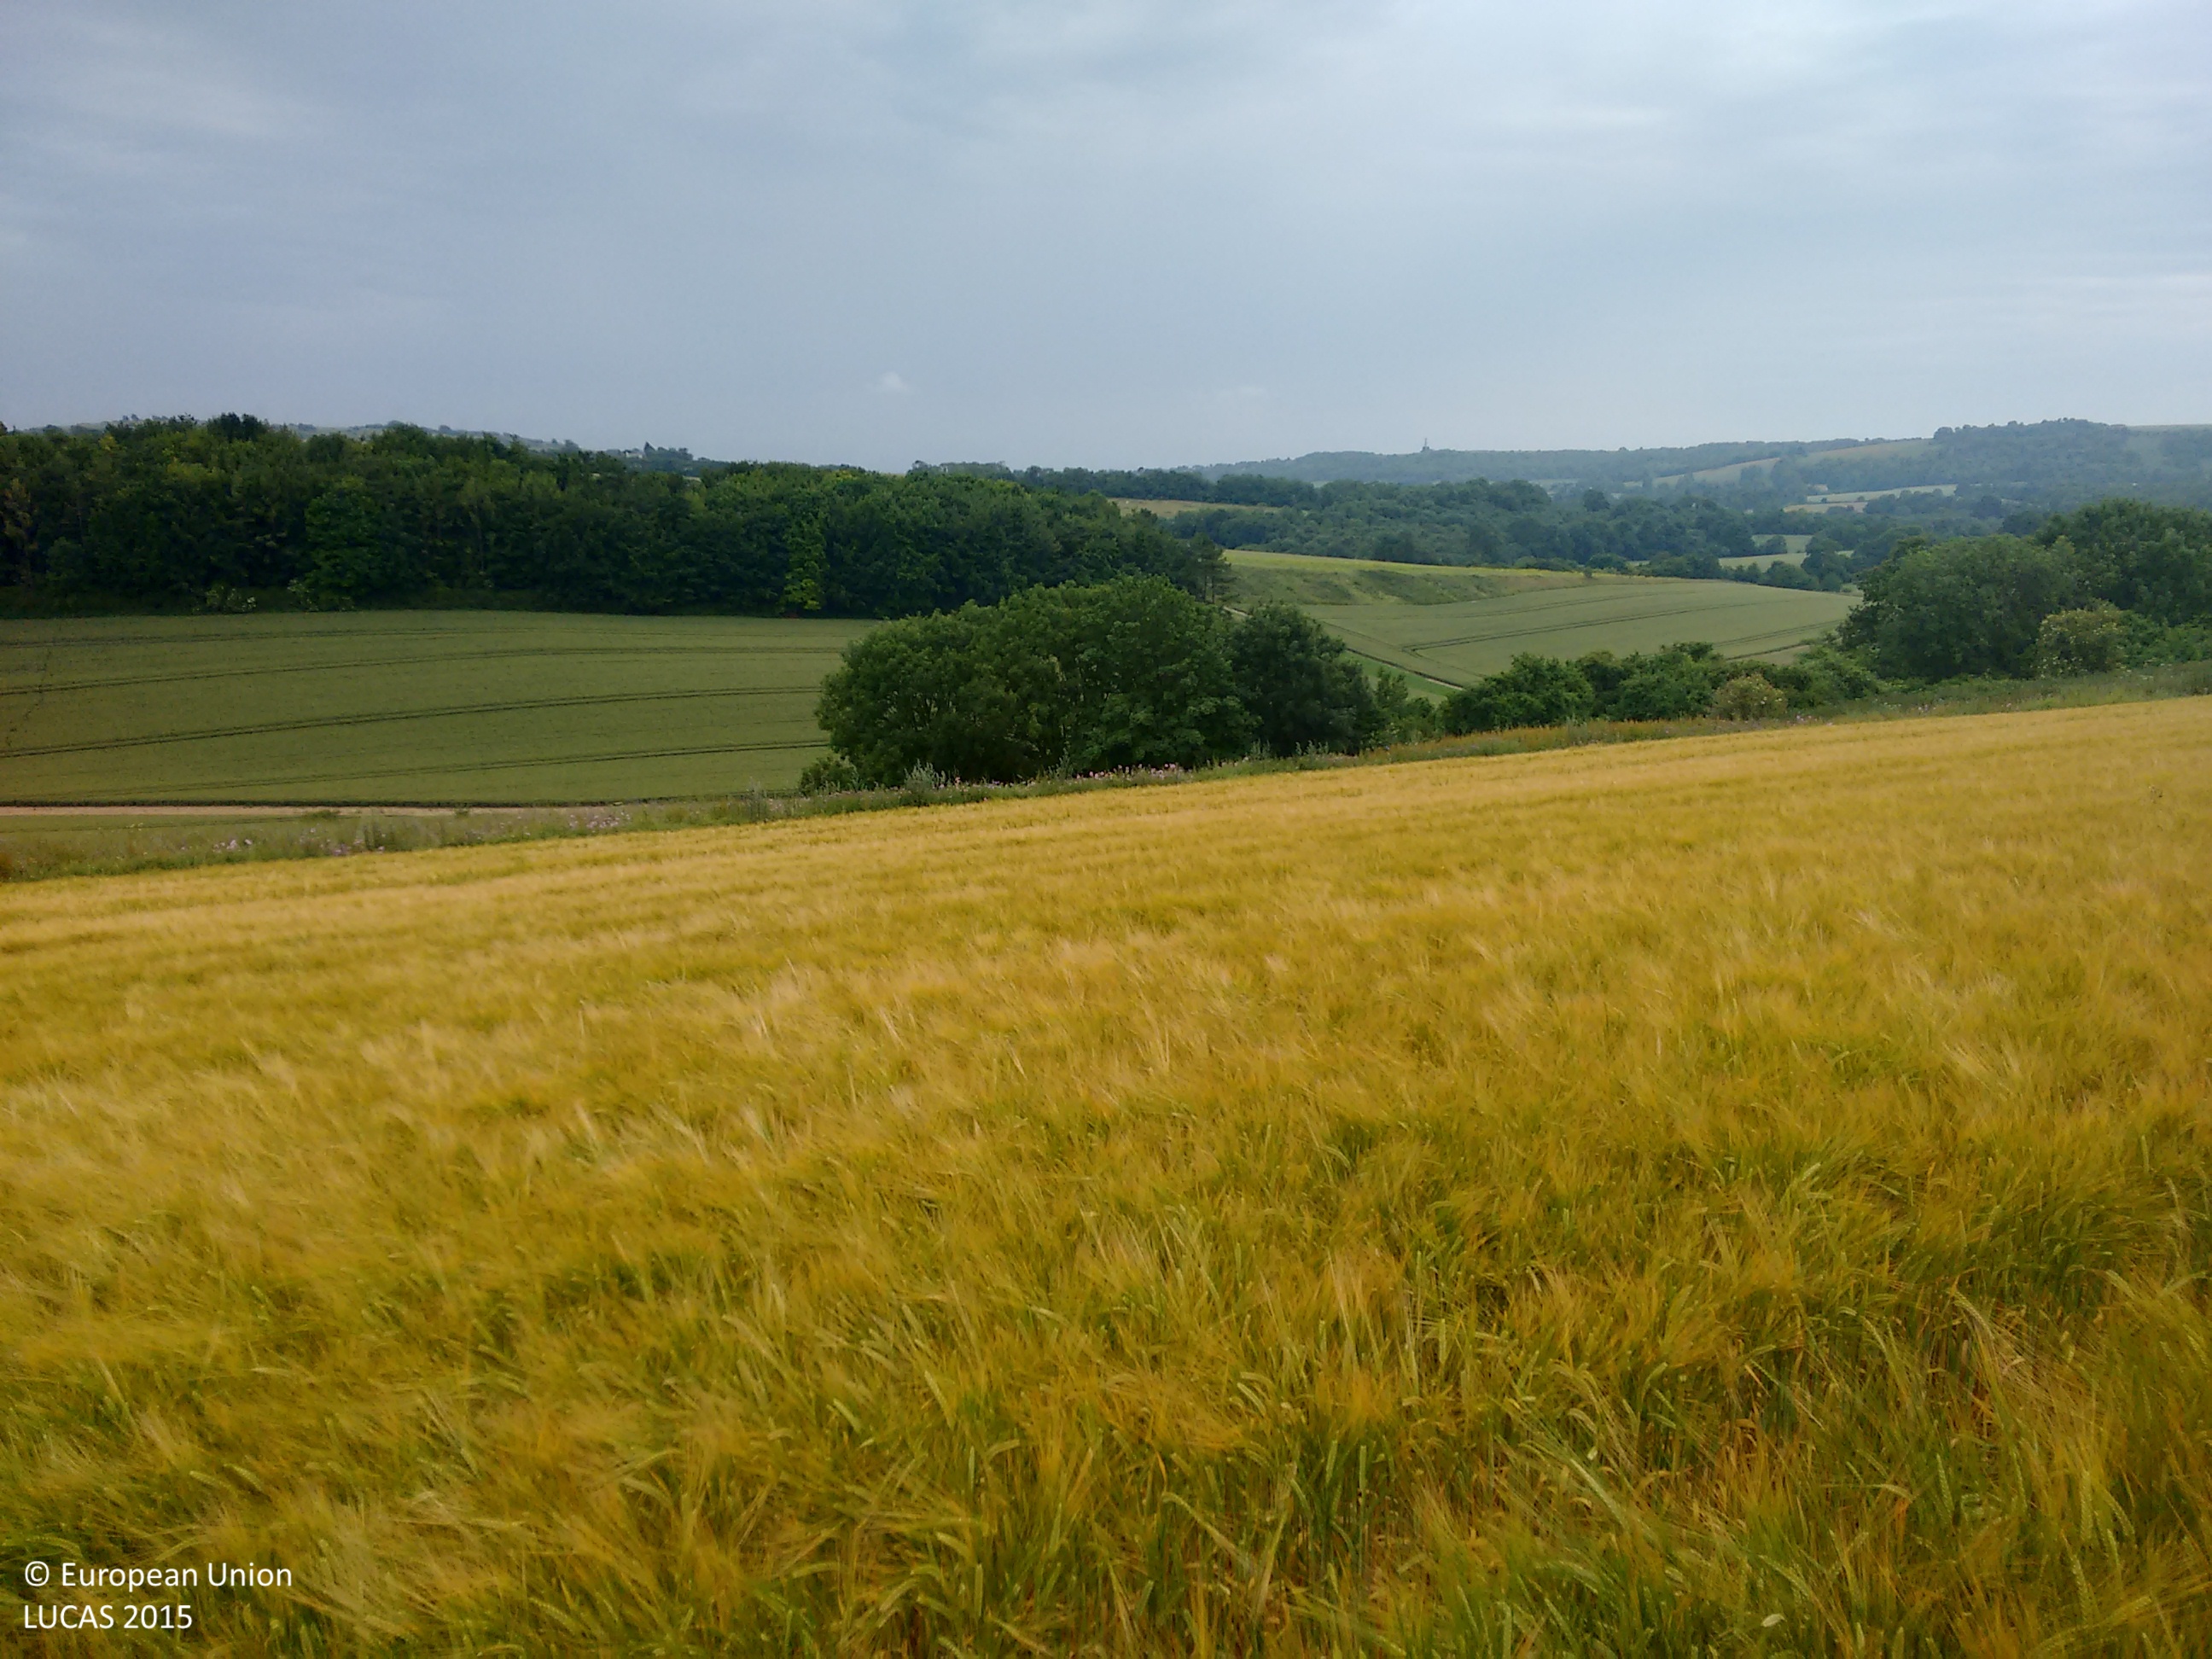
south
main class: Cropland
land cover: Barley
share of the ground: > 75 %
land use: Agriculture (excluding fallow land and kitchen gardens)
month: July
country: GB
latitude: 50.8859
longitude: -0.3997
